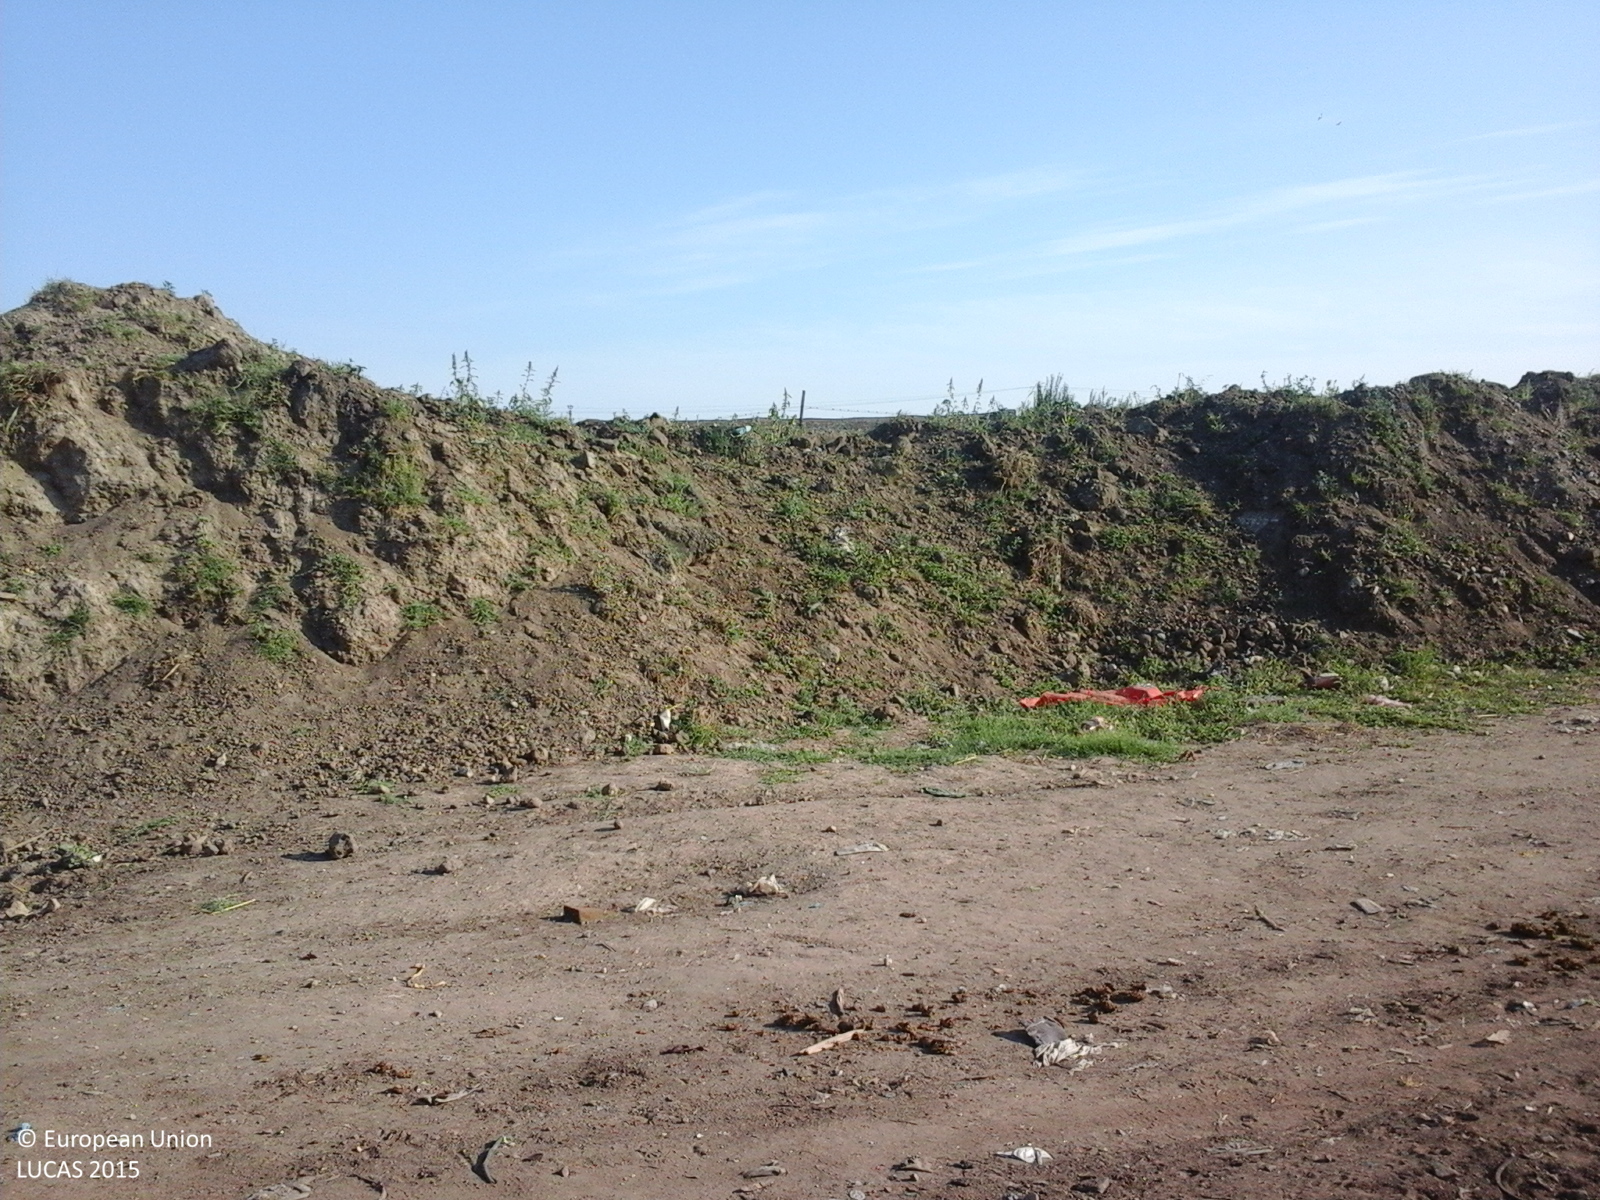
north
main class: Grassland
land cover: Spontaneously vegetated surfaces
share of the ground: 50 - 75 %
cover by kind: herbaceous plants 100 %
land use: Abandoned areas
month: August
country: RO
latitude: 44.0346
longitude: 23.1839
